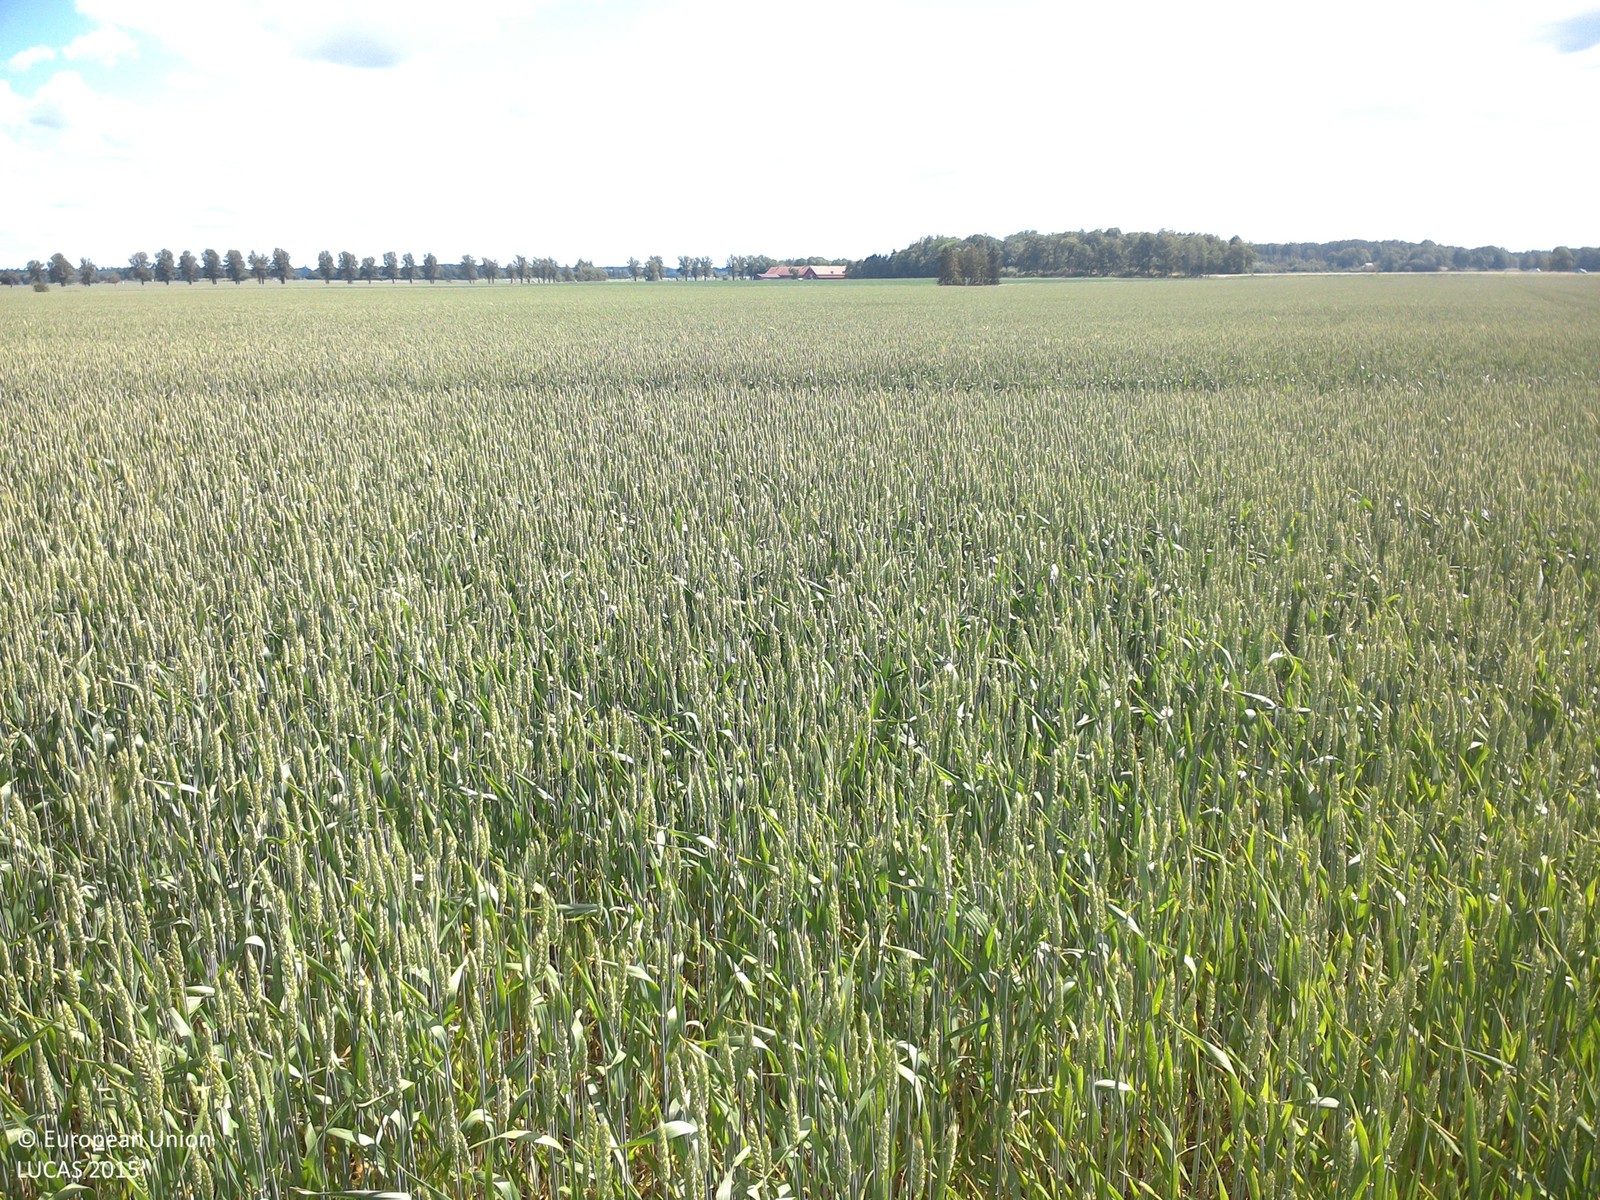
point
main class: Cropland
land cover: Common wheat
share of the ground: > 75 %
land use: Agriculture (excluding fallow land and kitchen gardens)
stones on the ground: < 10 %
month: July
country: SE
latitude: 58.3782
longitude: 15.4836
